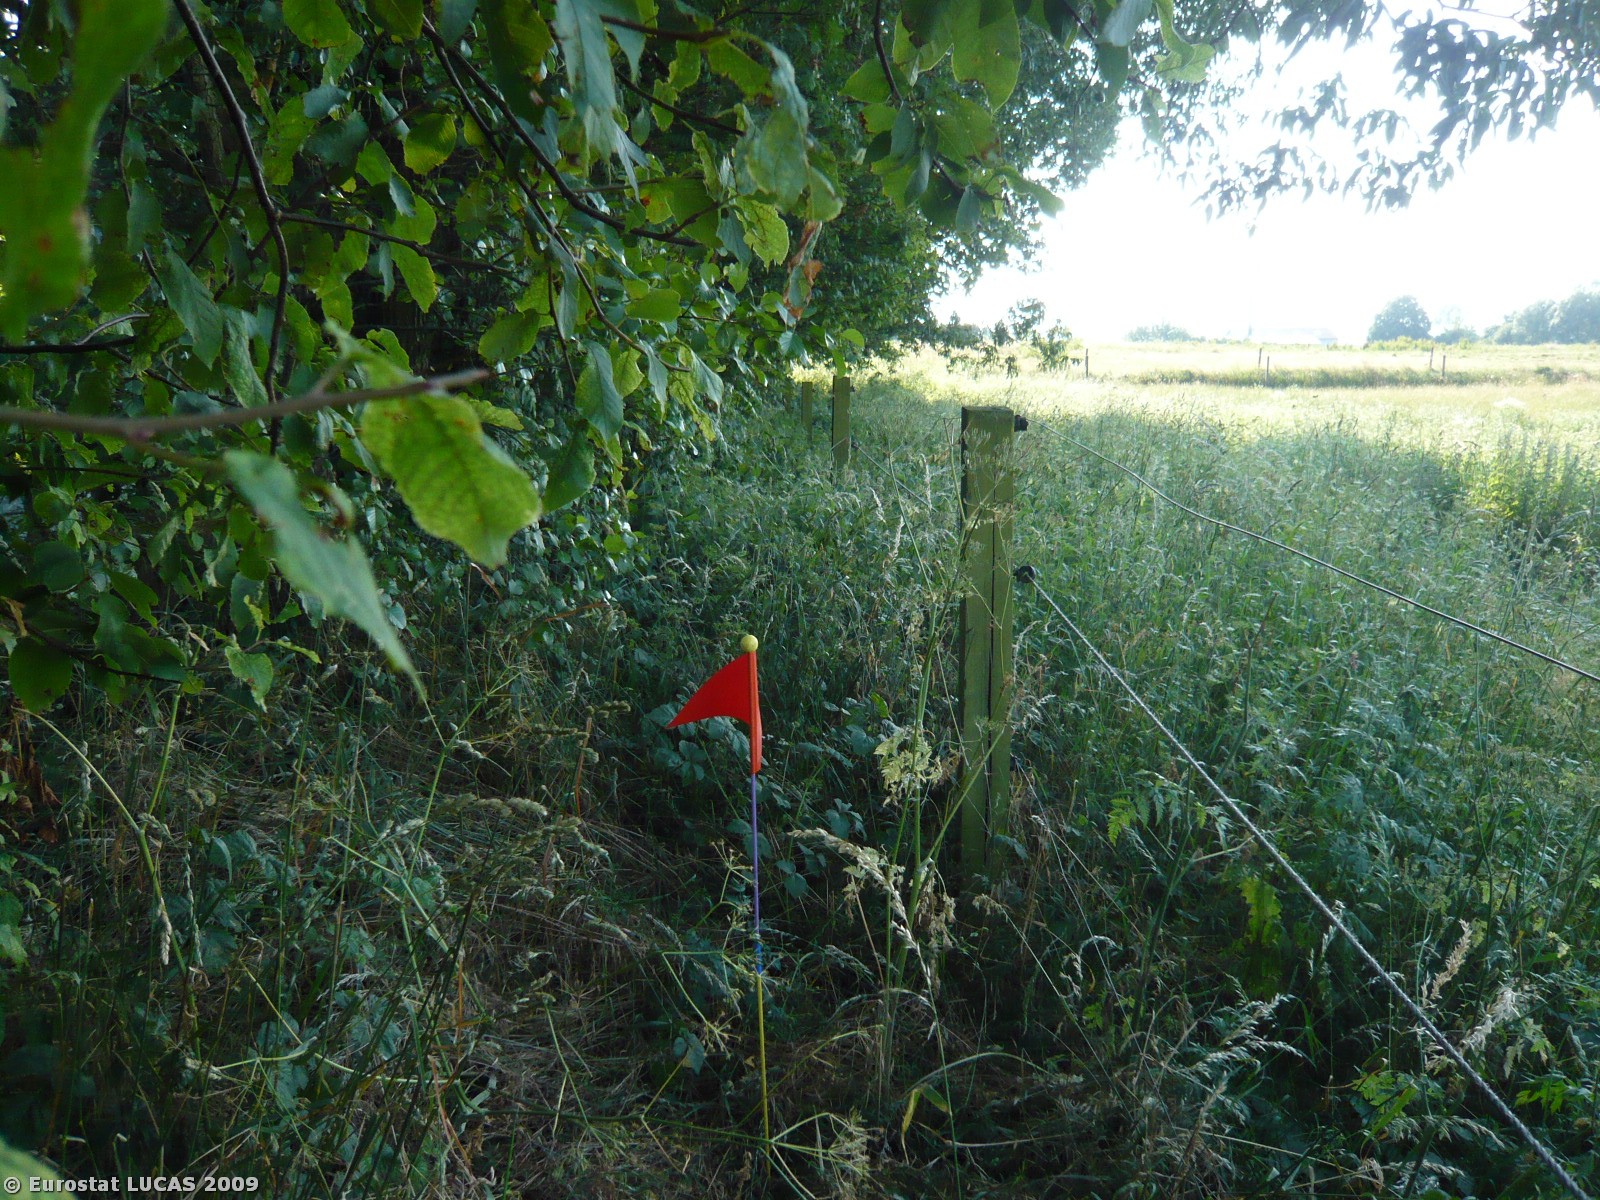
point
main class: Woodland
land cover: Broadleaved woodland
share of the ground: > 75 %
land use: Unused
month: July
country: DK
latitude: 55.4325
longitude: 10.2684
